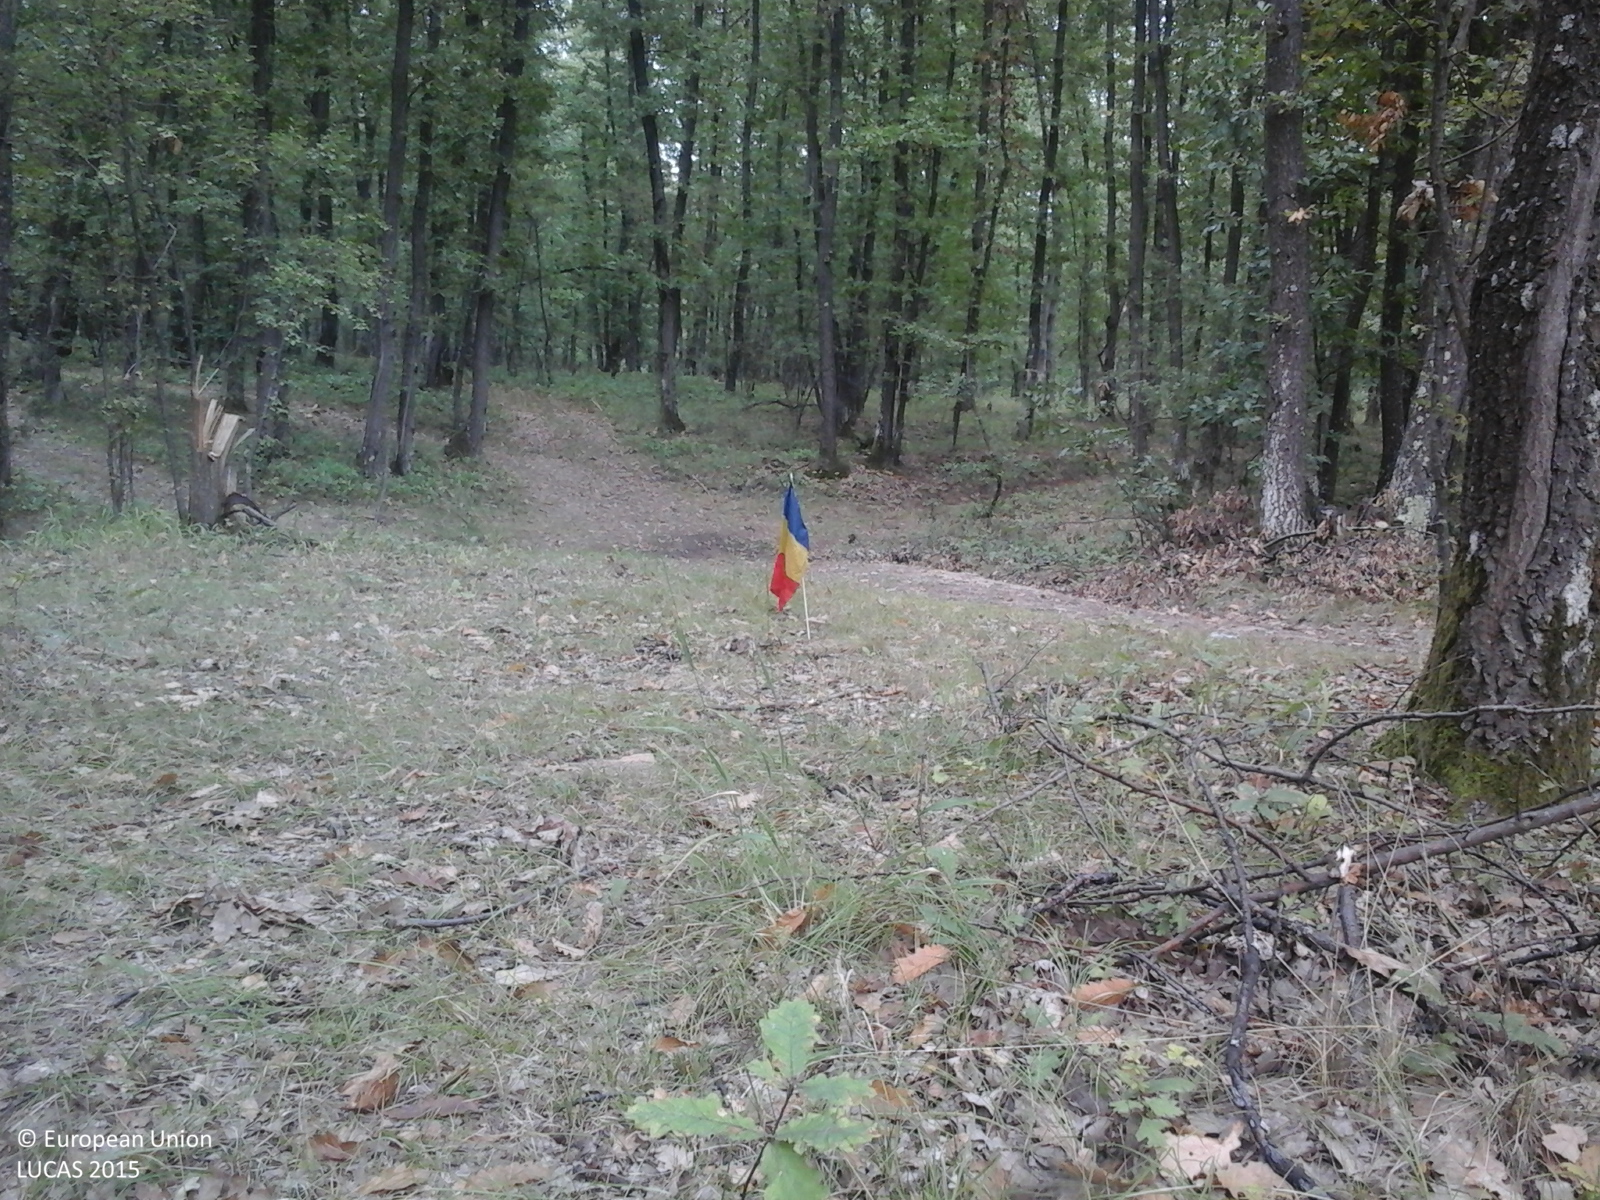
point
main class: Woodland
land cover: Broadleaved woodland
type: acidophilous oak and oak-birch forest
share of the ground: > 75 %
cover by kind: broadleaved forest trees 100 %
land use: Forestry
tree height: > 5 m
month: September
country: RO
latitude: 45.0115
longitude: 23.1074
